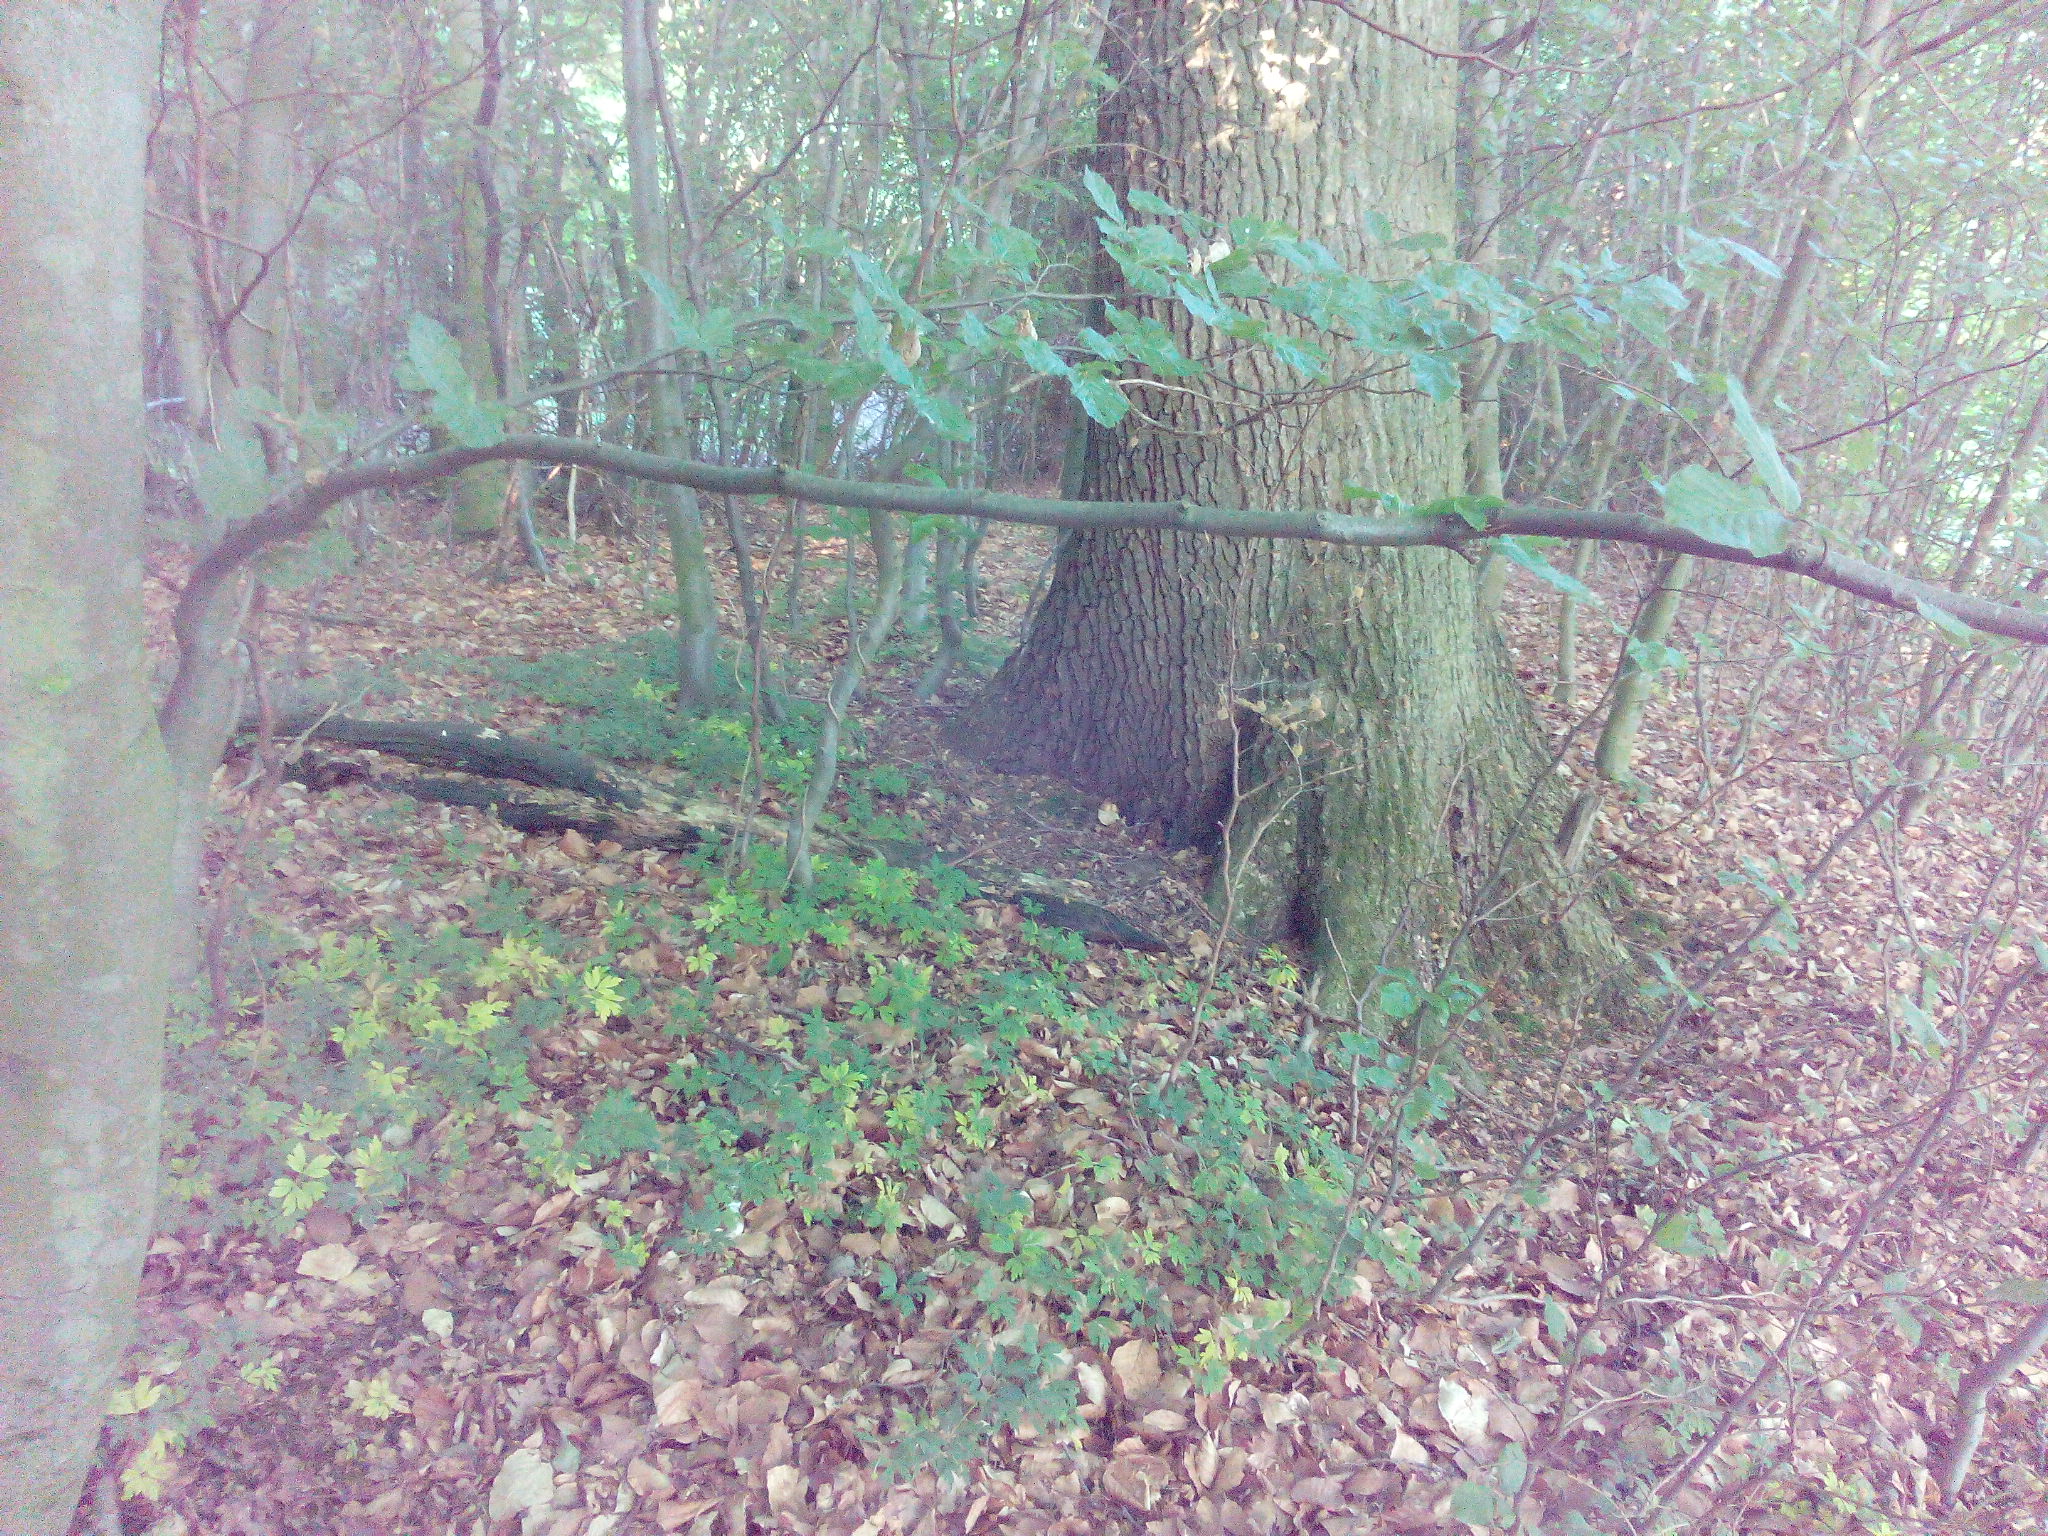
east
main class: Woodland
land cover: Broadleaved woodland
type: mesophytic deciduous forest
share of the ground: > 75 %
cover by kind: broadleaved forest trees 90 %, herbaceous plants 5 %, unconsolidated bare surface 5 %
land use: Forestry
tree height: > 5 m
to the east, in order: Broadleaved woodland; Tracks; Broadleaved woodland; Tracks; Broadleaved woodland
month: May
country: DE
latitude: 53.7905
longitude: 13.2327
